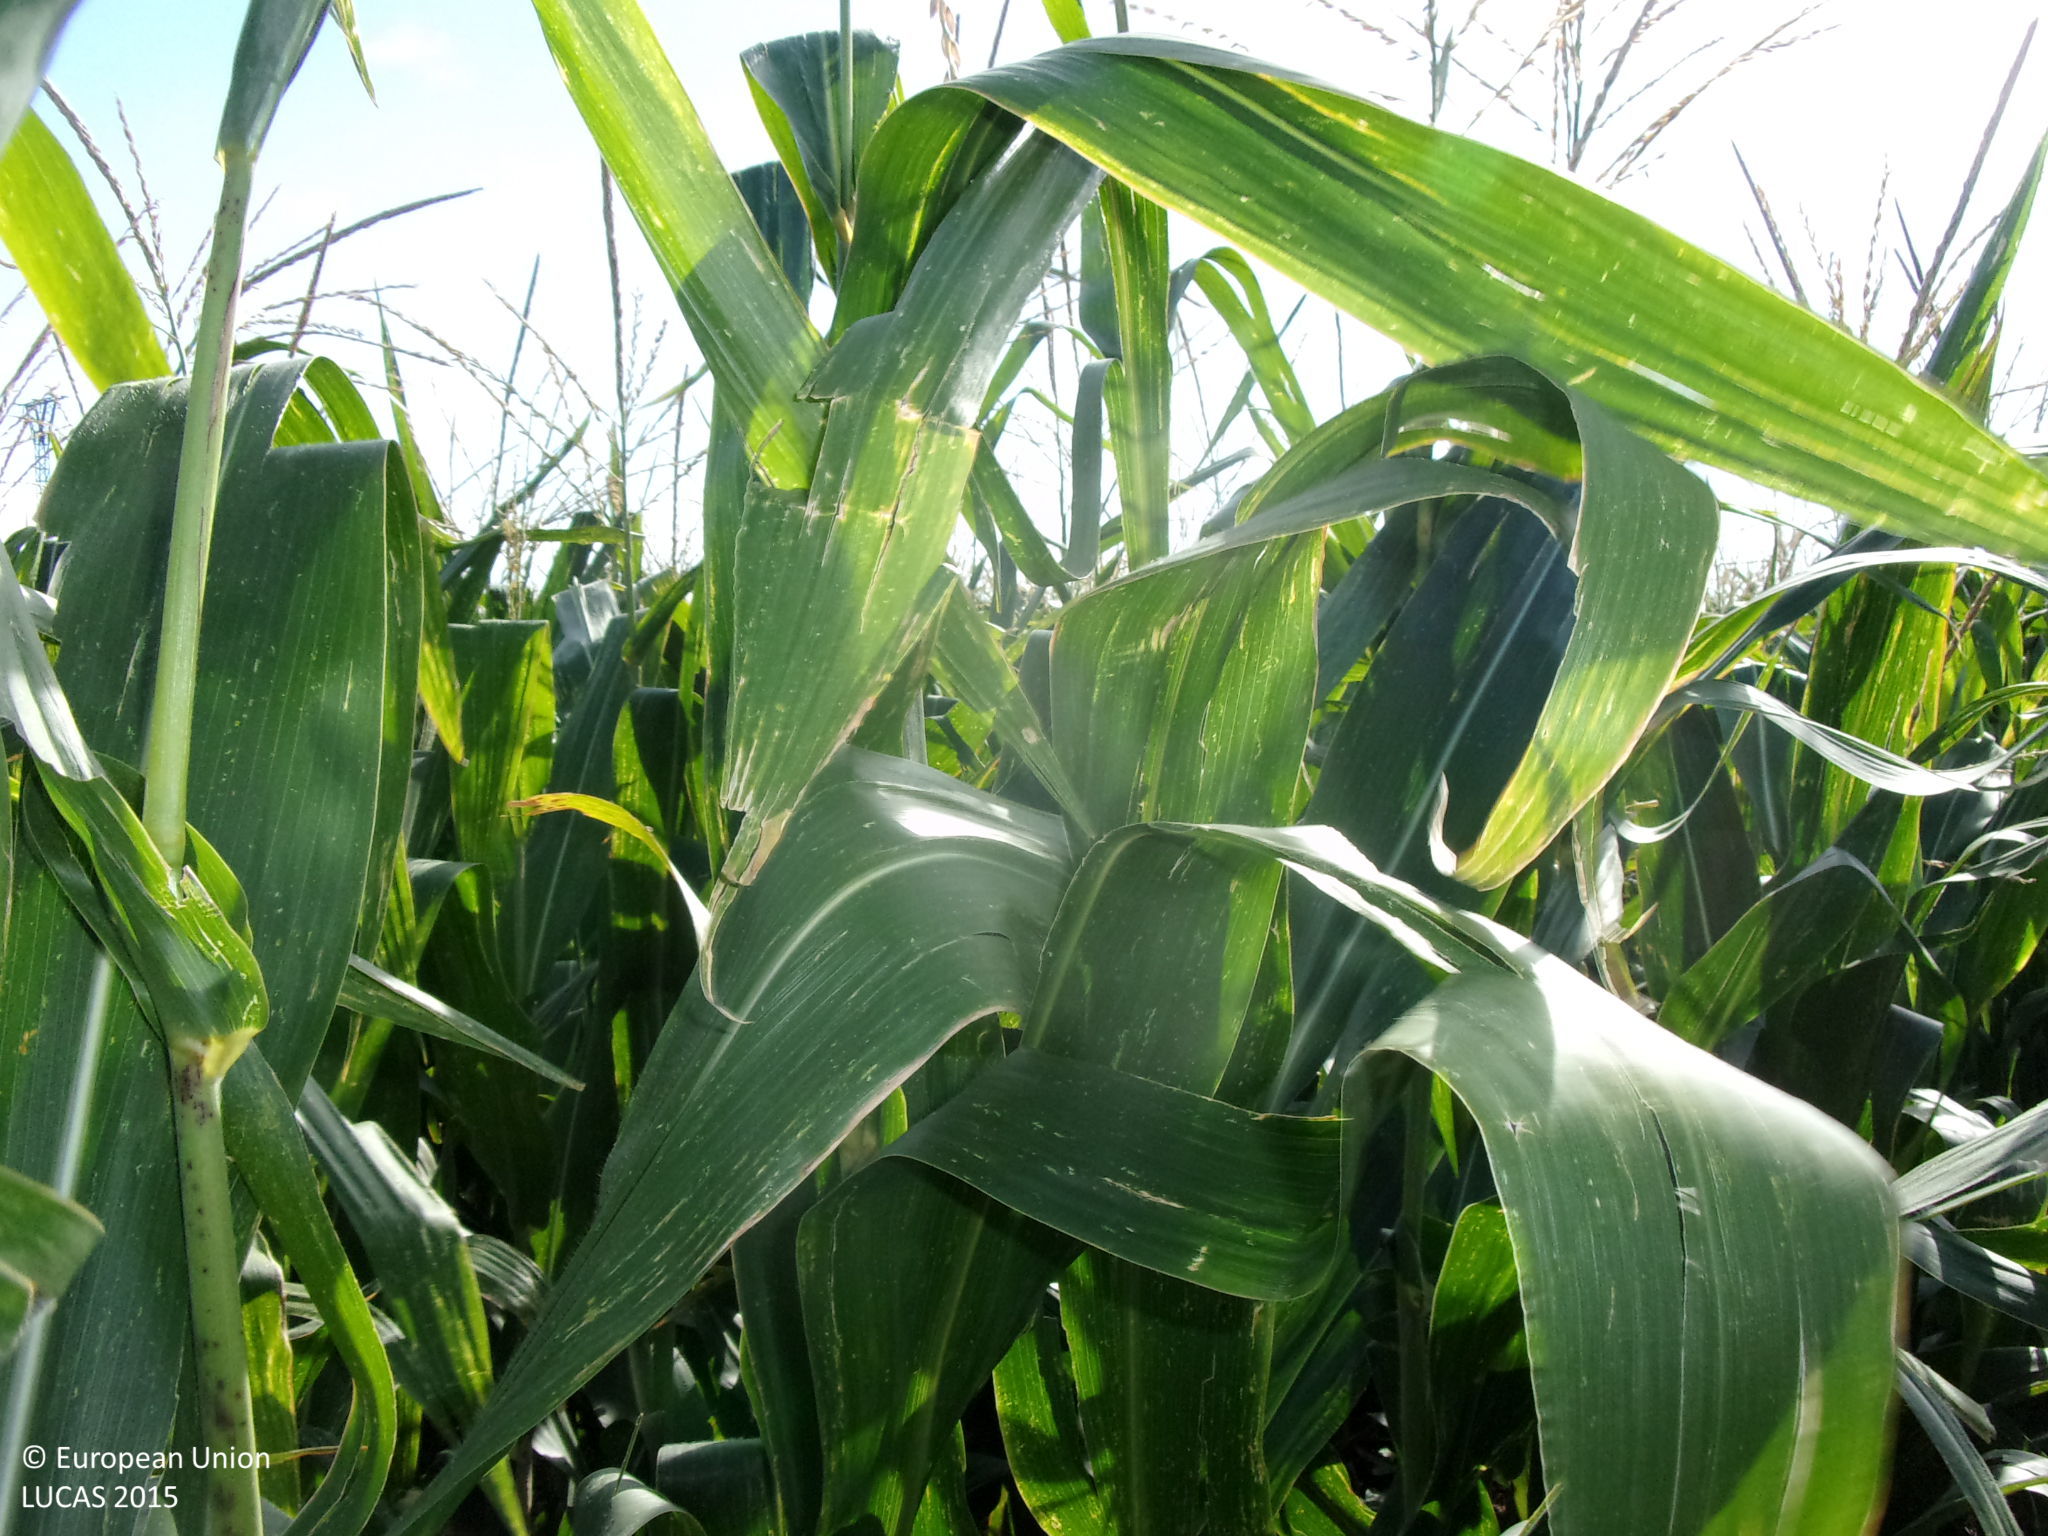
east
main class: Cropland
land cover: Maize
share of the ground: > 75 %
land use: Agriculture (excluding fallow land and kitchen gardens)
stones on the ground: 10 - 25 %
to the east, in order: Maize; Grass margins; Tracks; Grass margins; Maize
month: August
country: ES
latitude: 42.0593
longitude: -1.1084
